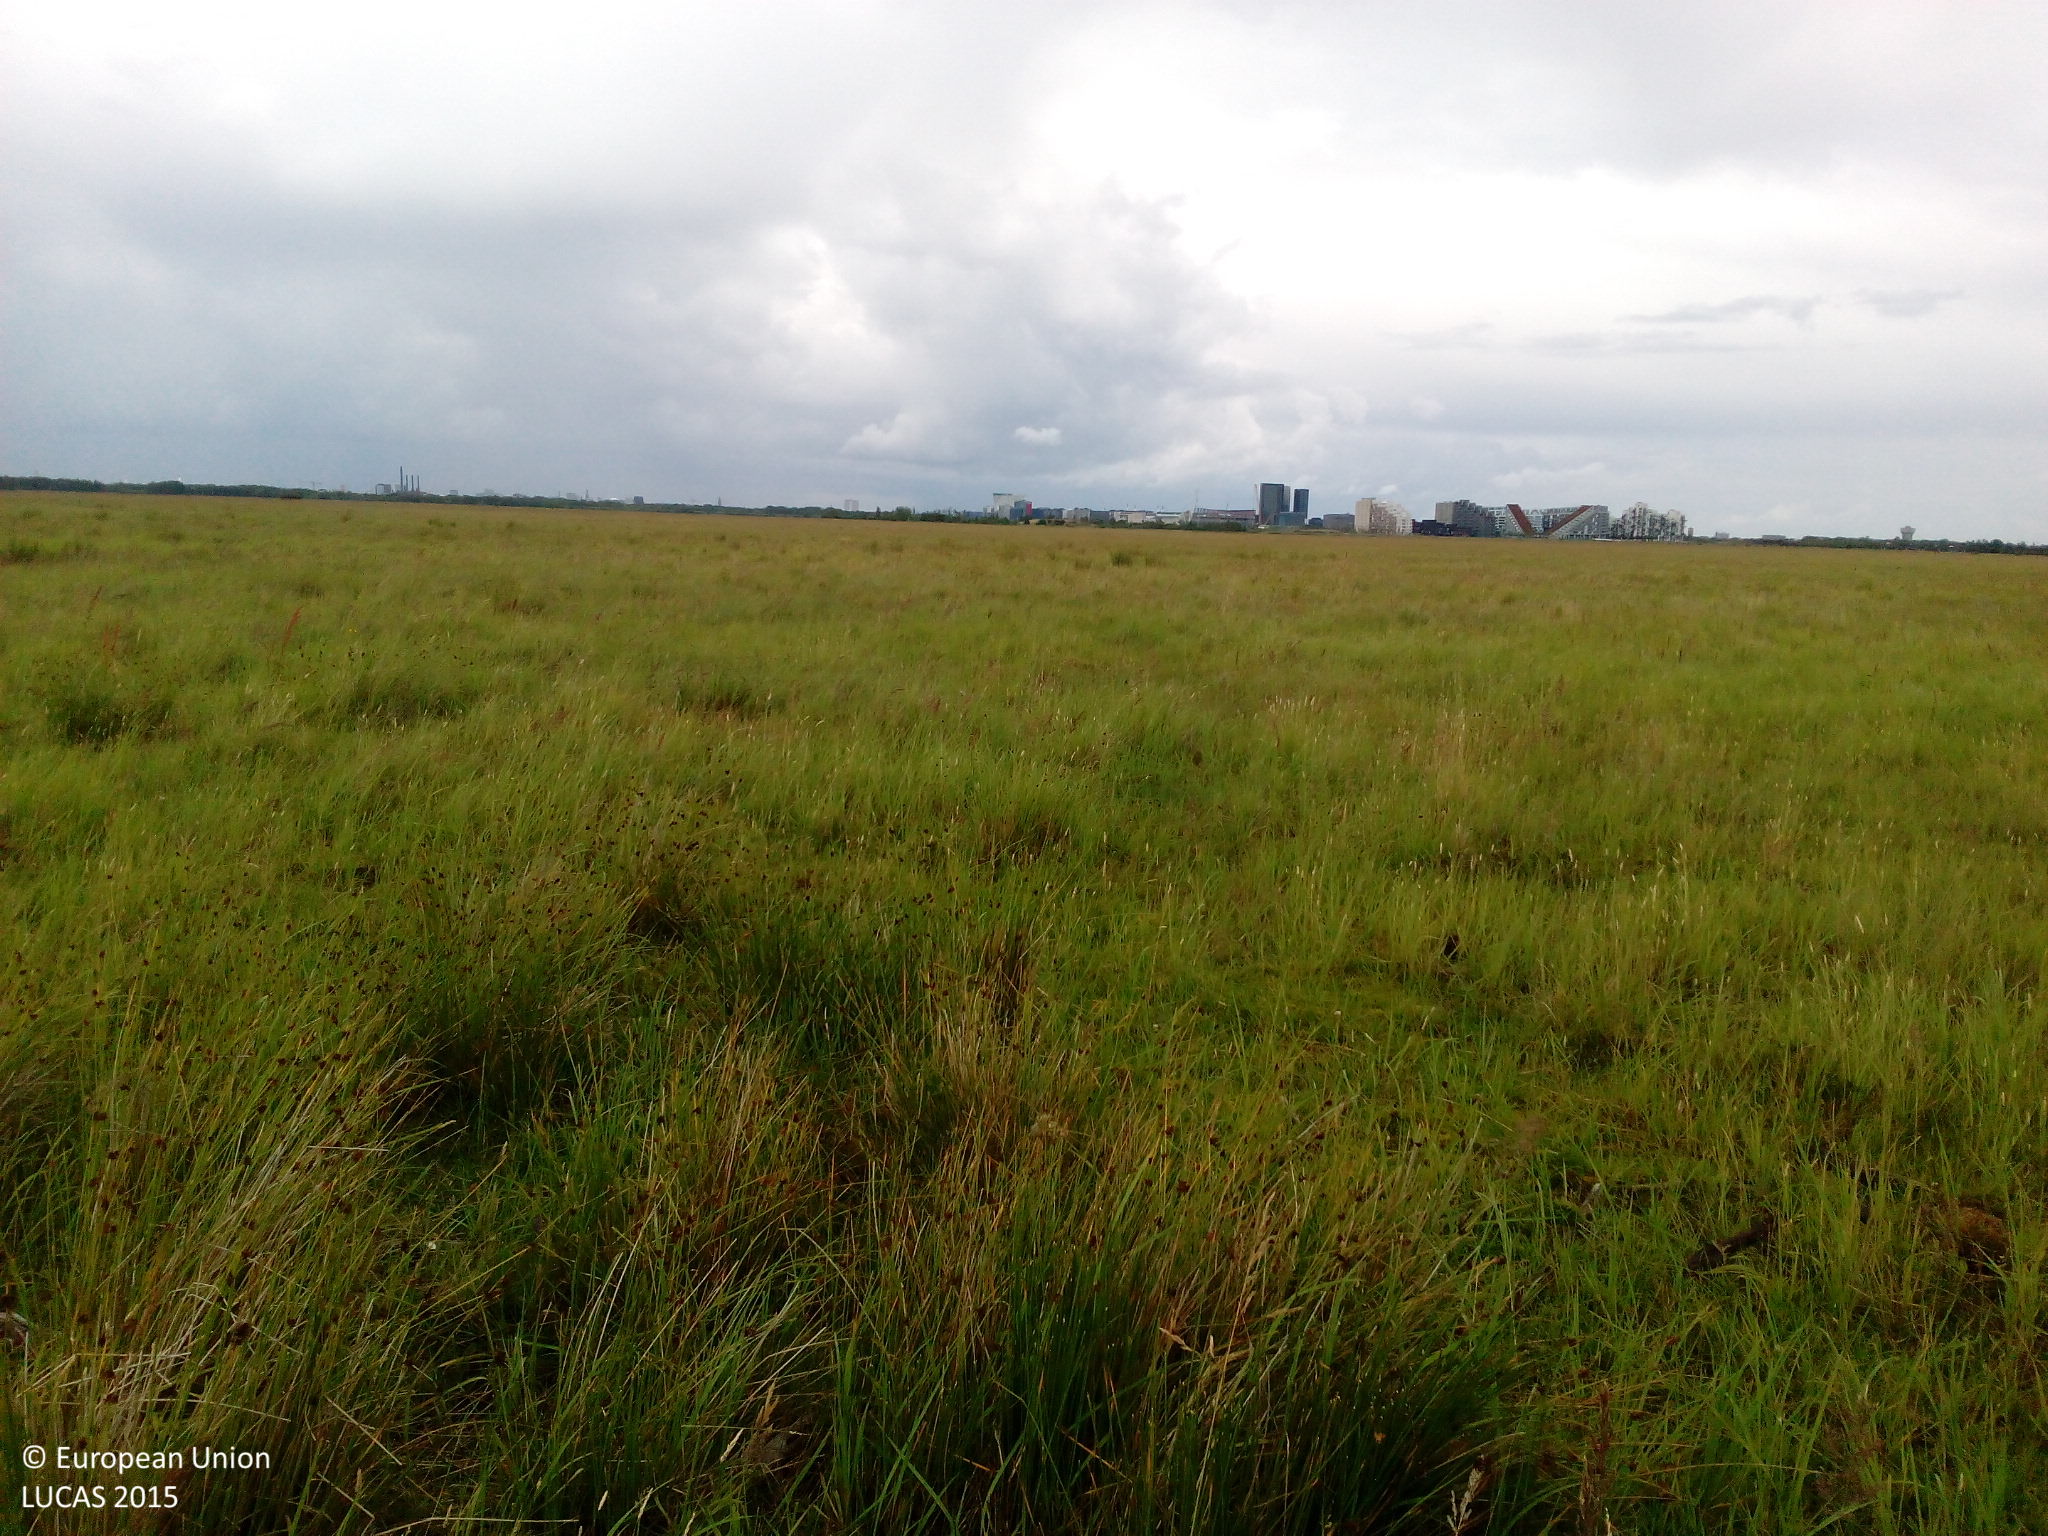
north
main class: Grassland
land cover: Grassland without tree/shrub cover
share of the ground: > 75 %
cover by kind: herbaceous plants 100 %
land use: Agriculture (excluding fallow land and kitchen gardens)
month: July
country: DK
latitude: 55.6048
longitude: 12.5536
